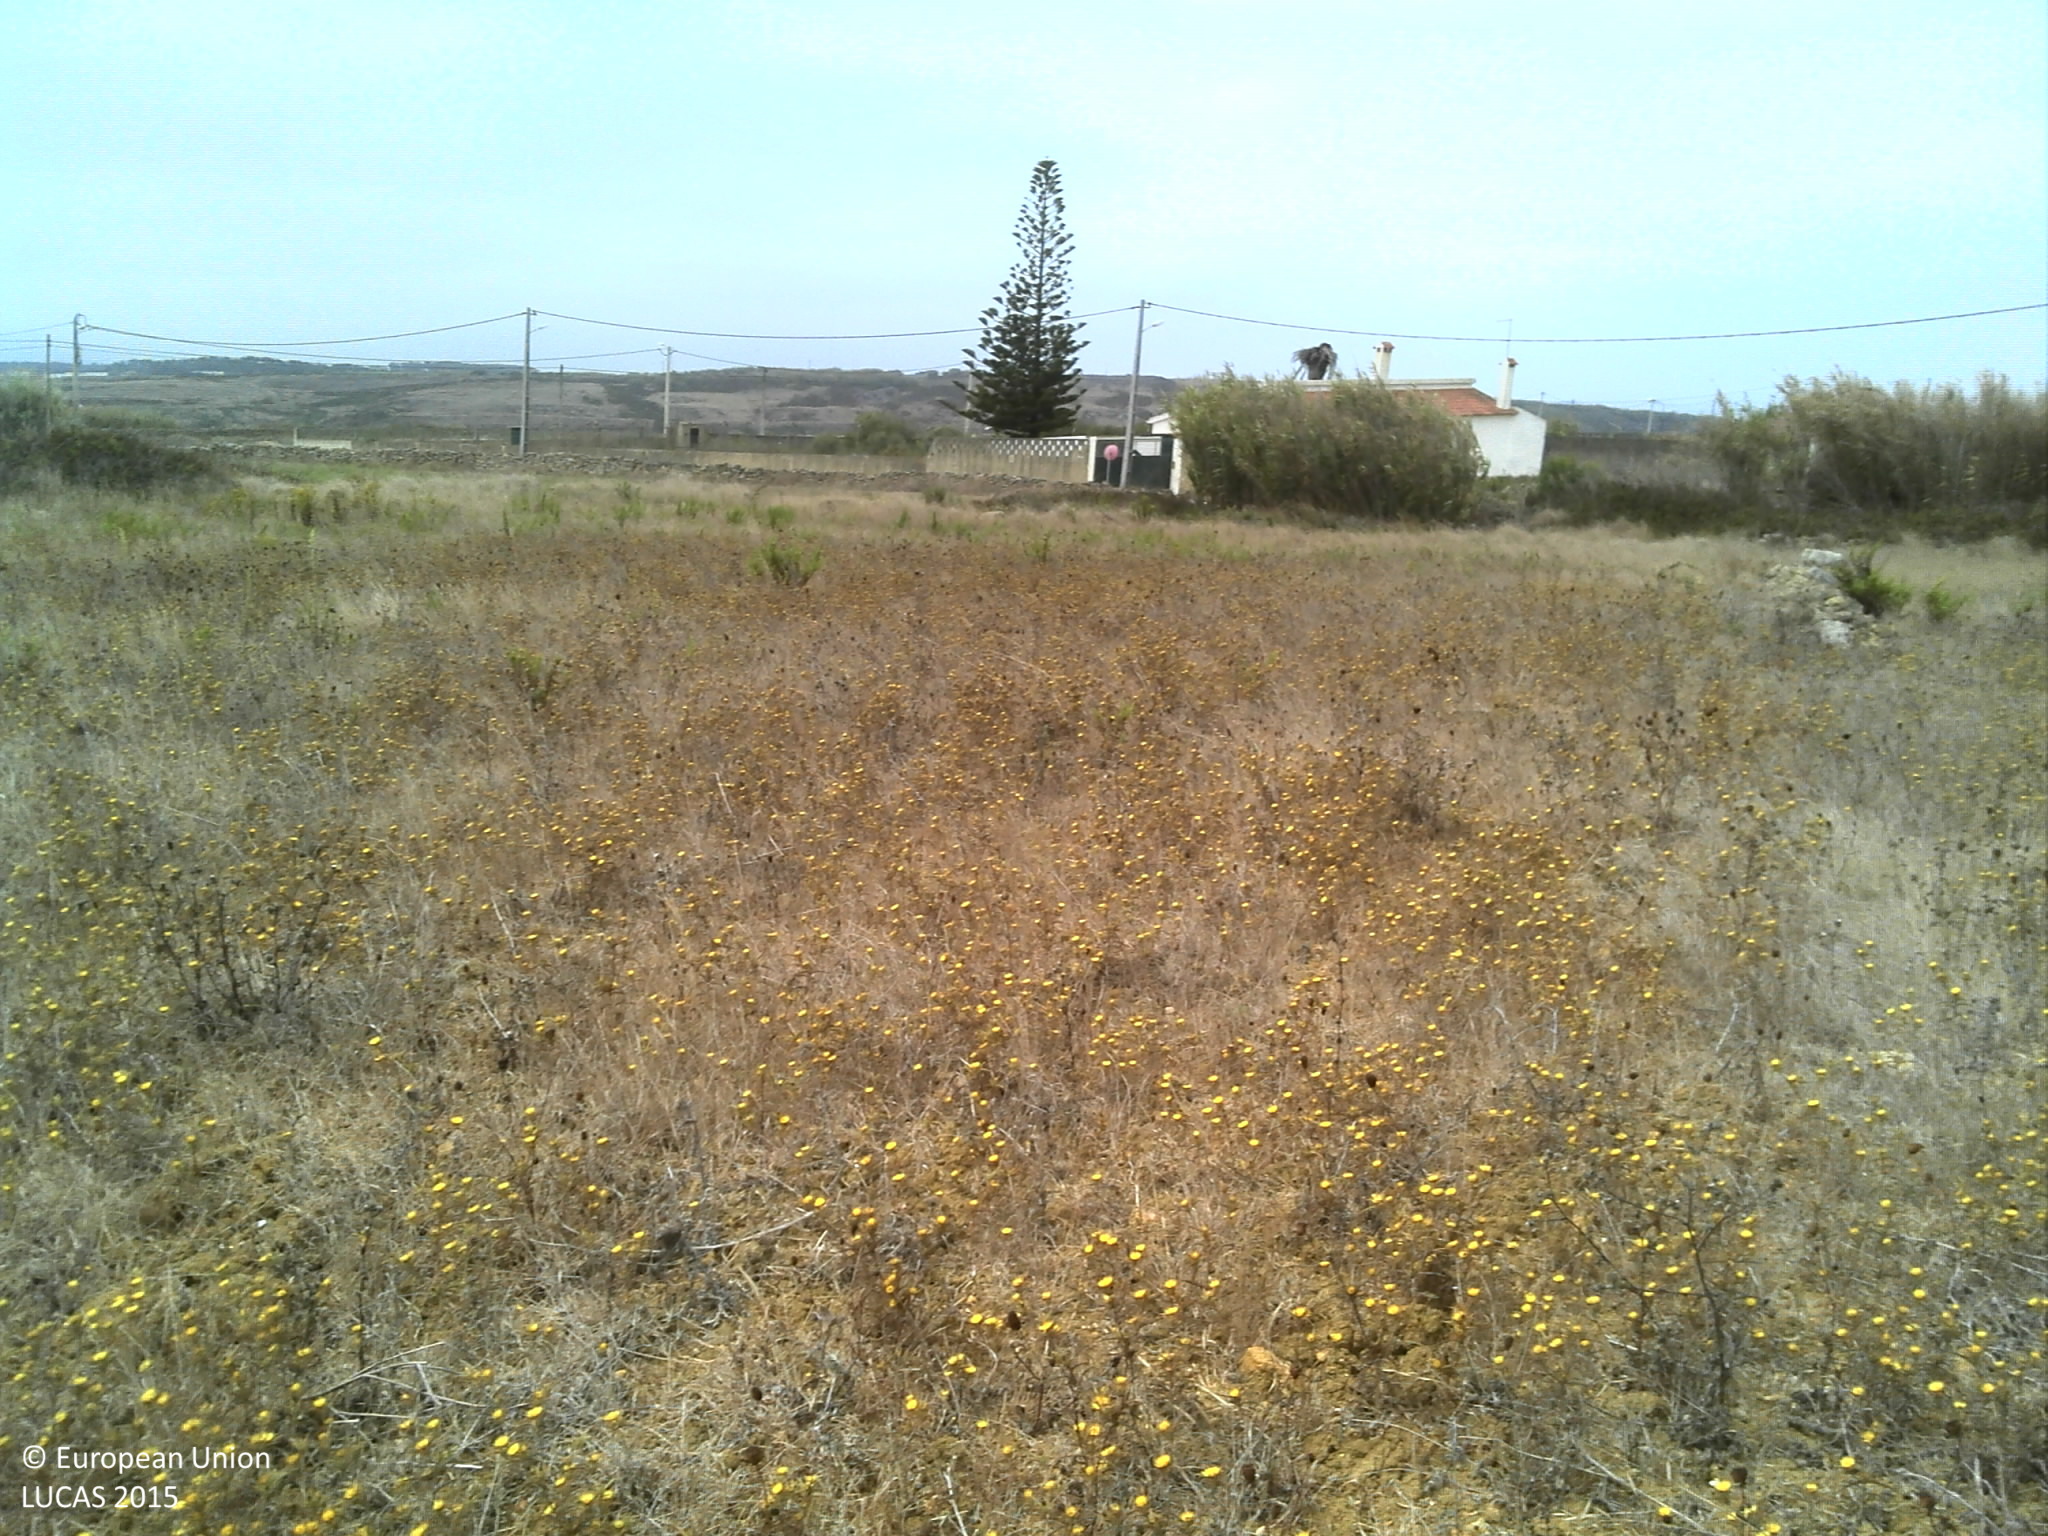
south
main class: Grassland
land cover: Grassland without tree/shrub cover
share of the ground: 25 - 50 %
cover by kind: unconsolidated bare surface 60 %, herbaceous plants 40 %
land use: Agriculture (excluding fallow land and kitchen gardens)
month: August
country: PT
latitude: 38.8984
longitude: -9.4234
